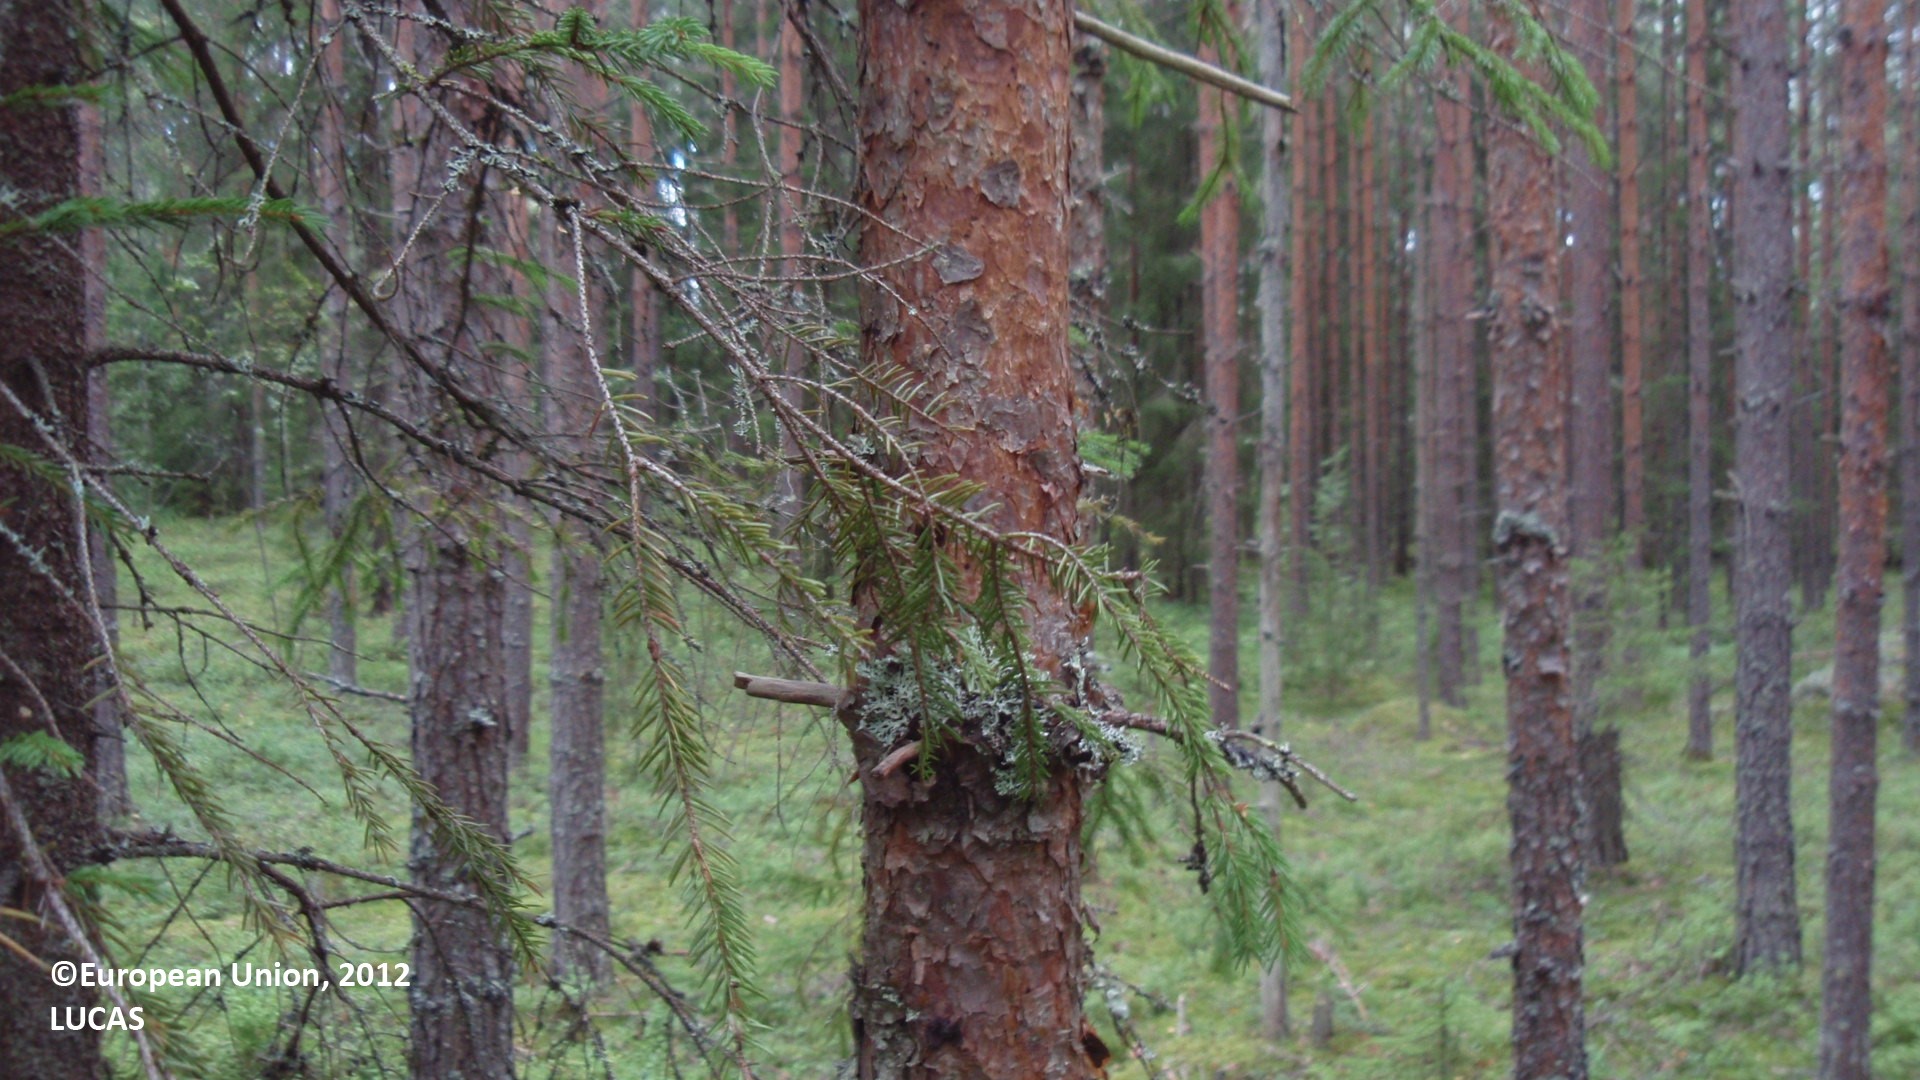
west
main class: Woodland
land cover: Pine dominated mixed woodland
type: boreal forest
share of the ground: 50 - 75 %
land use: Forestry
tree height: > 5 m
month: August
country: FI
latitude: 60.9331
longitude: 27.4334
